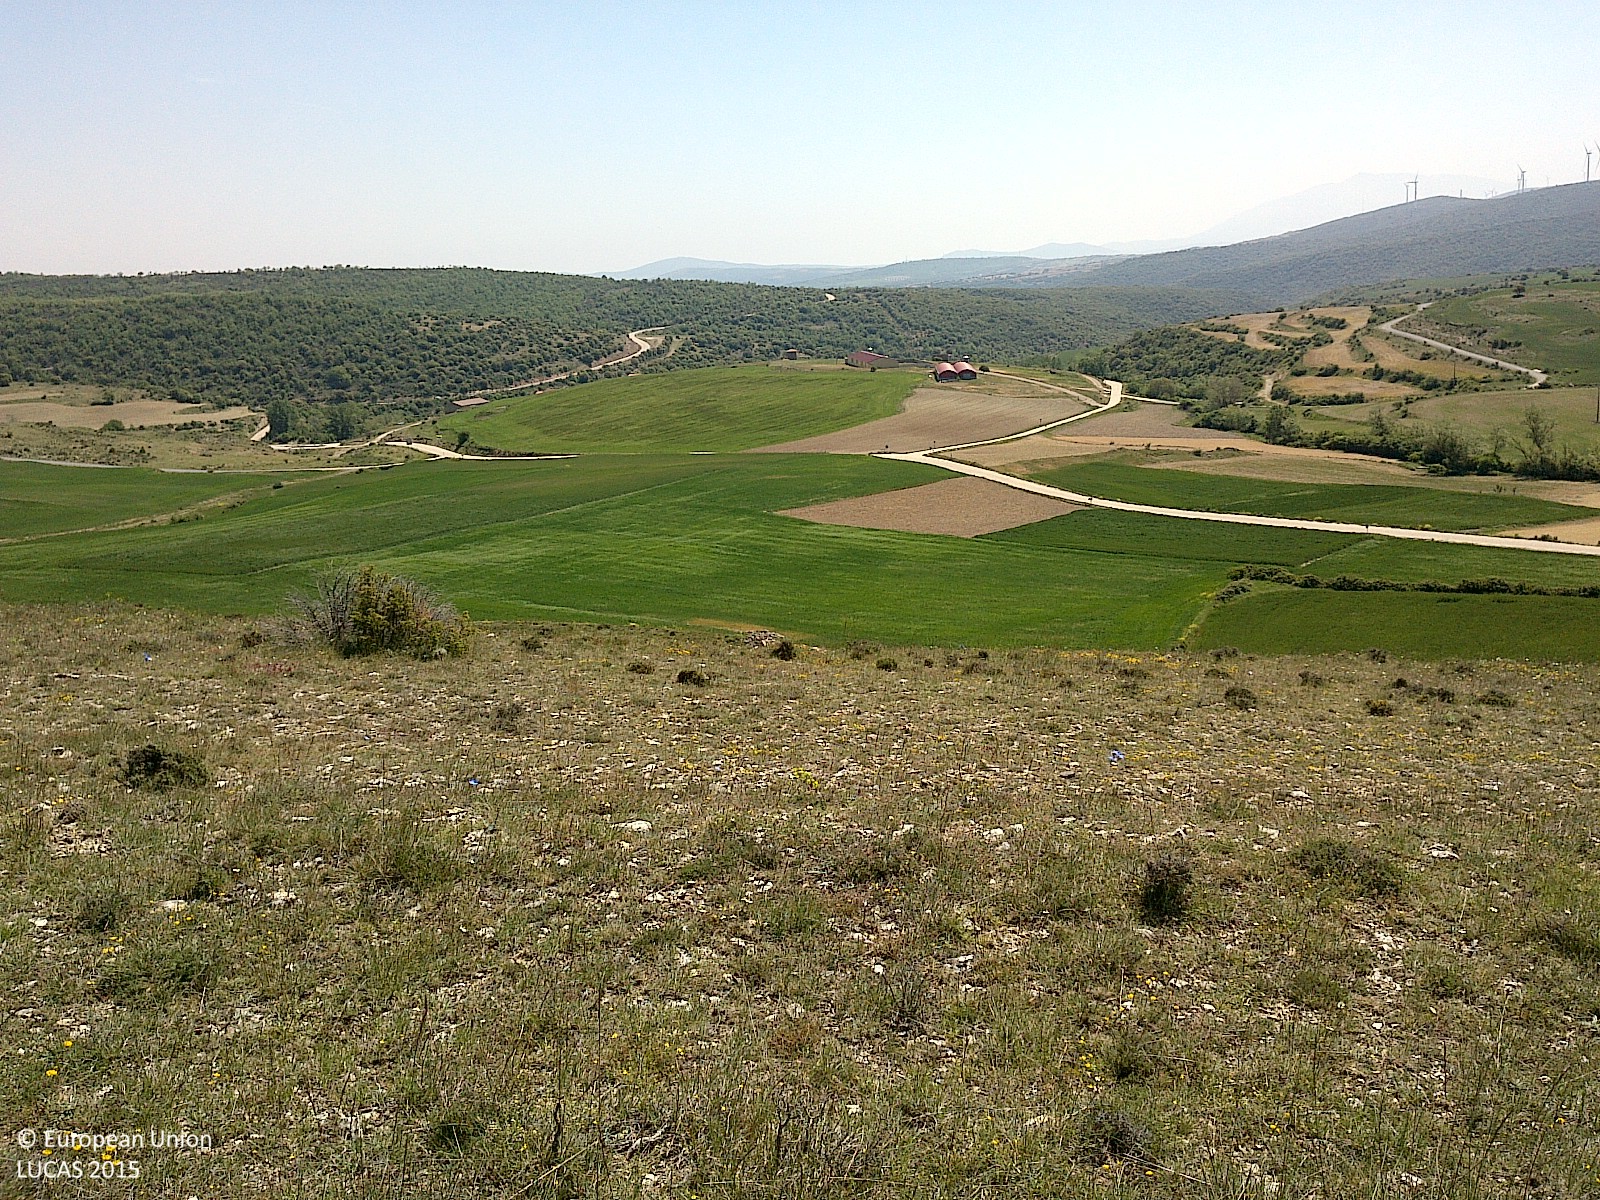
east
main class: Grassland
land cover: Grassland without tree/shrub cover
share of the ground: > 75 %
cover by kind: herbaceous plants 85 %, consolidated bare surface 10 %, shrubs 5 %
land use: Semi-natural and natural areas not in use
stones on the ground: < 10 %
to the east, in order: Grassland without tree/shrub cover; Shrubland without tree cover; Rock outcrops; Shrubland without tree cover; Barley; Grass margins; Barley
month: May
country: ES
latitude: 41.8897
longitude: -2.2454
